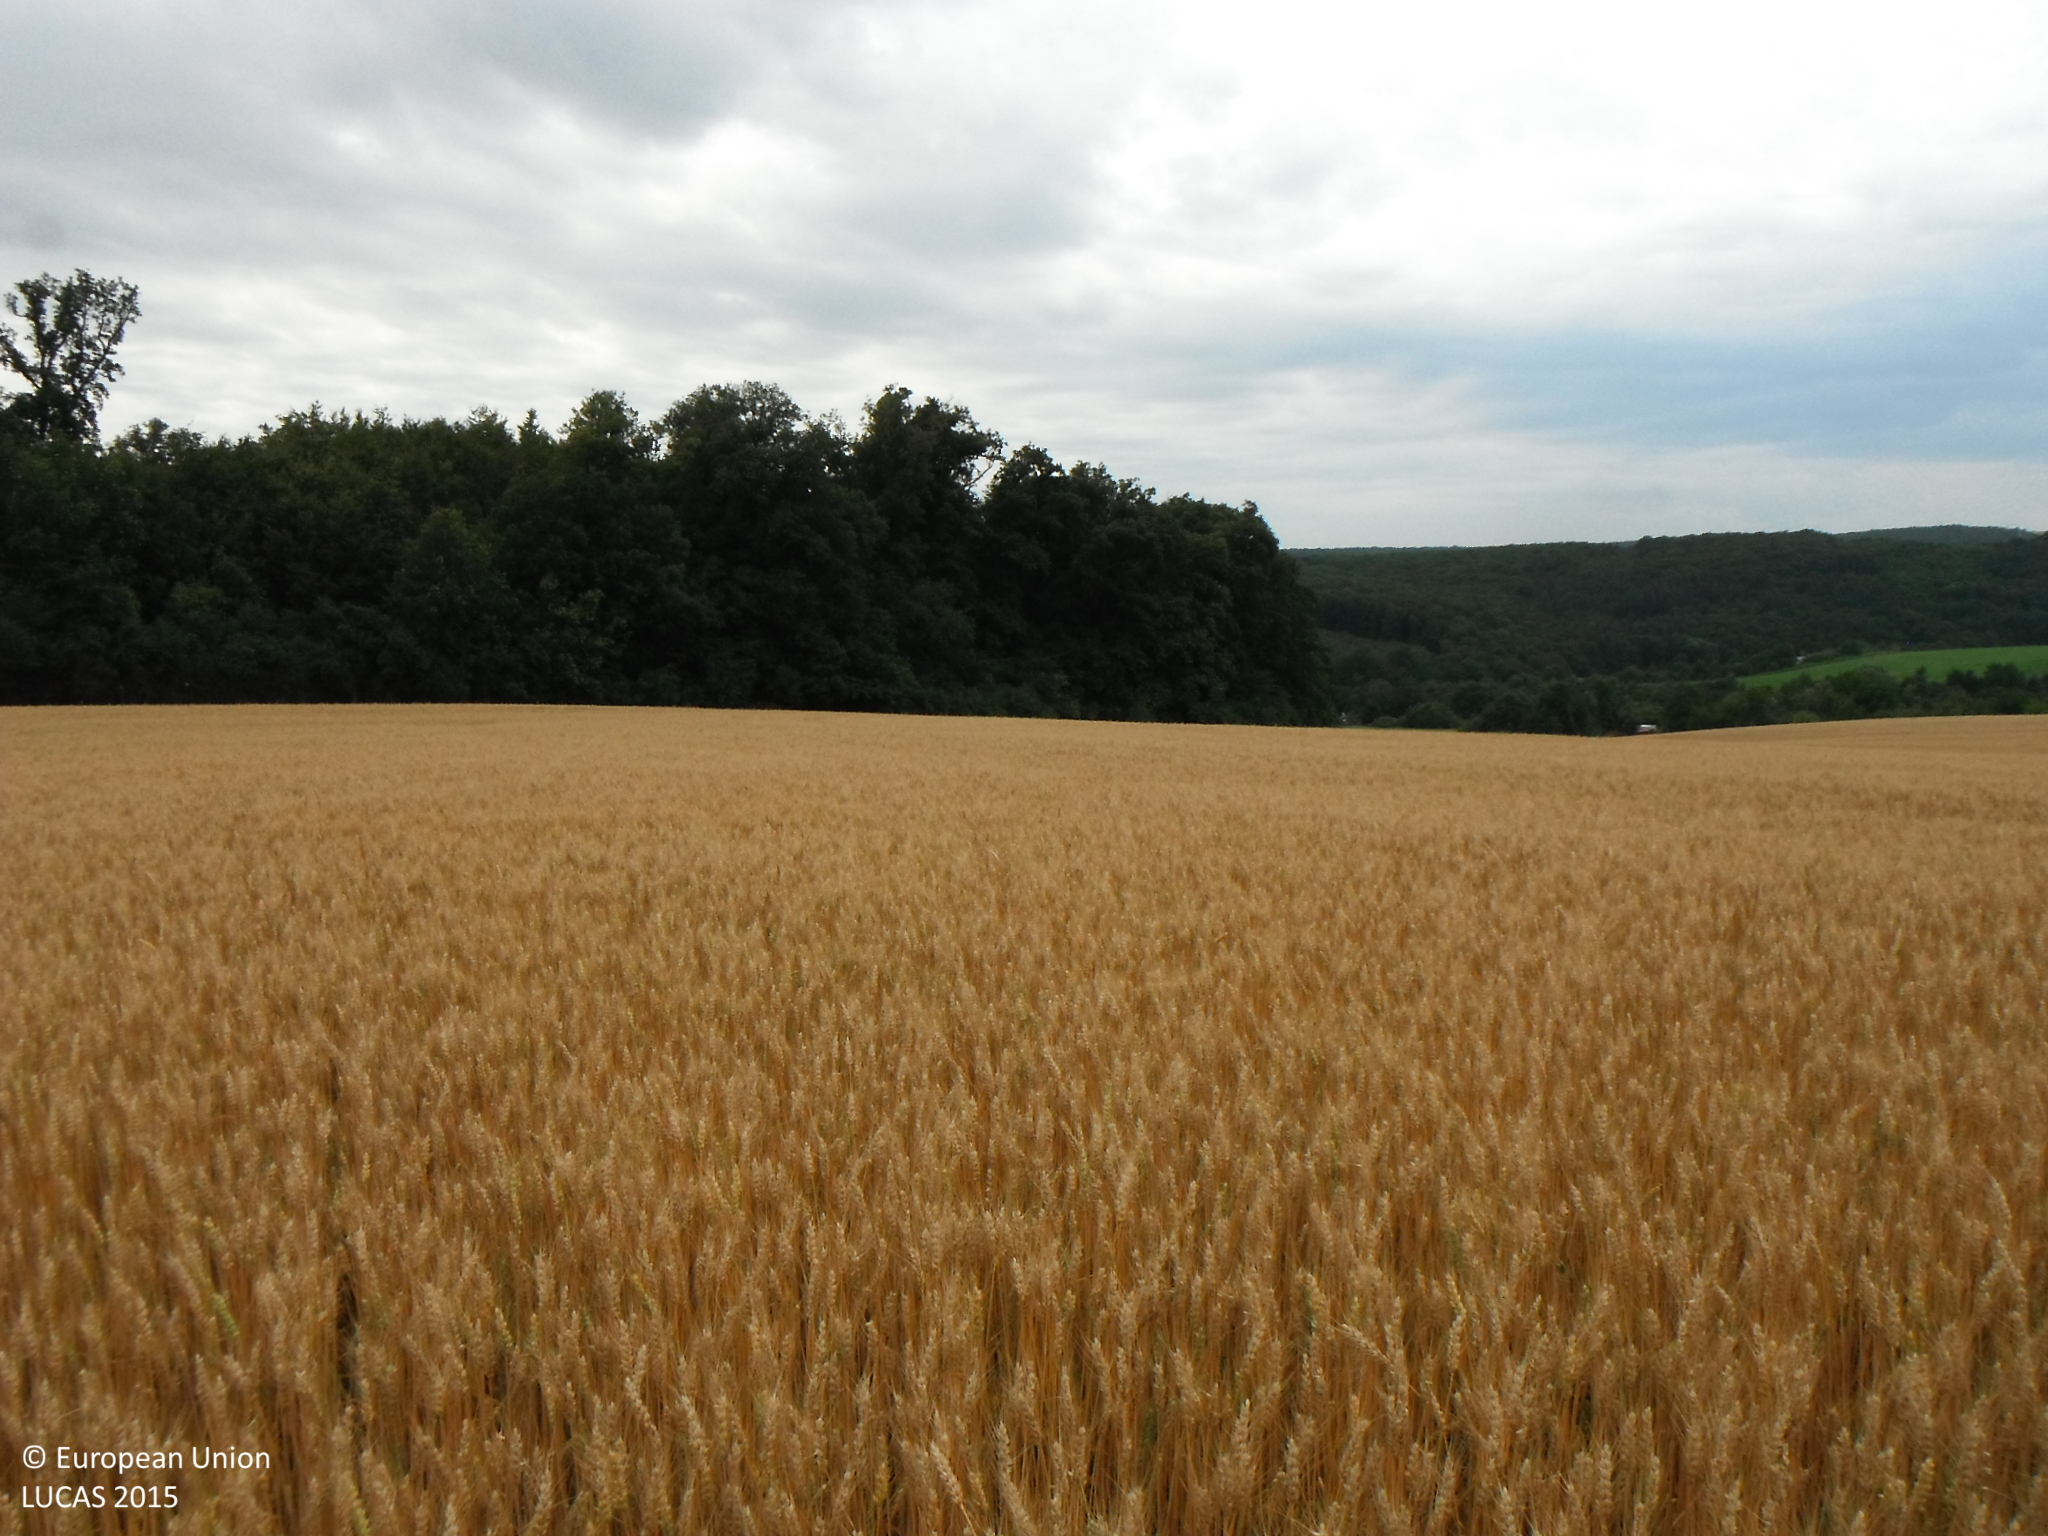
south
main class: Cropland
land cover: Common wheat
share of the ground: > 75 %
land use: Agriculture (excluding fallow land and kitchen gardens)
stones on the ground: 10 - 25 %
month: July
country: SK
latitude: 48.7289
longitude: 21.3156
